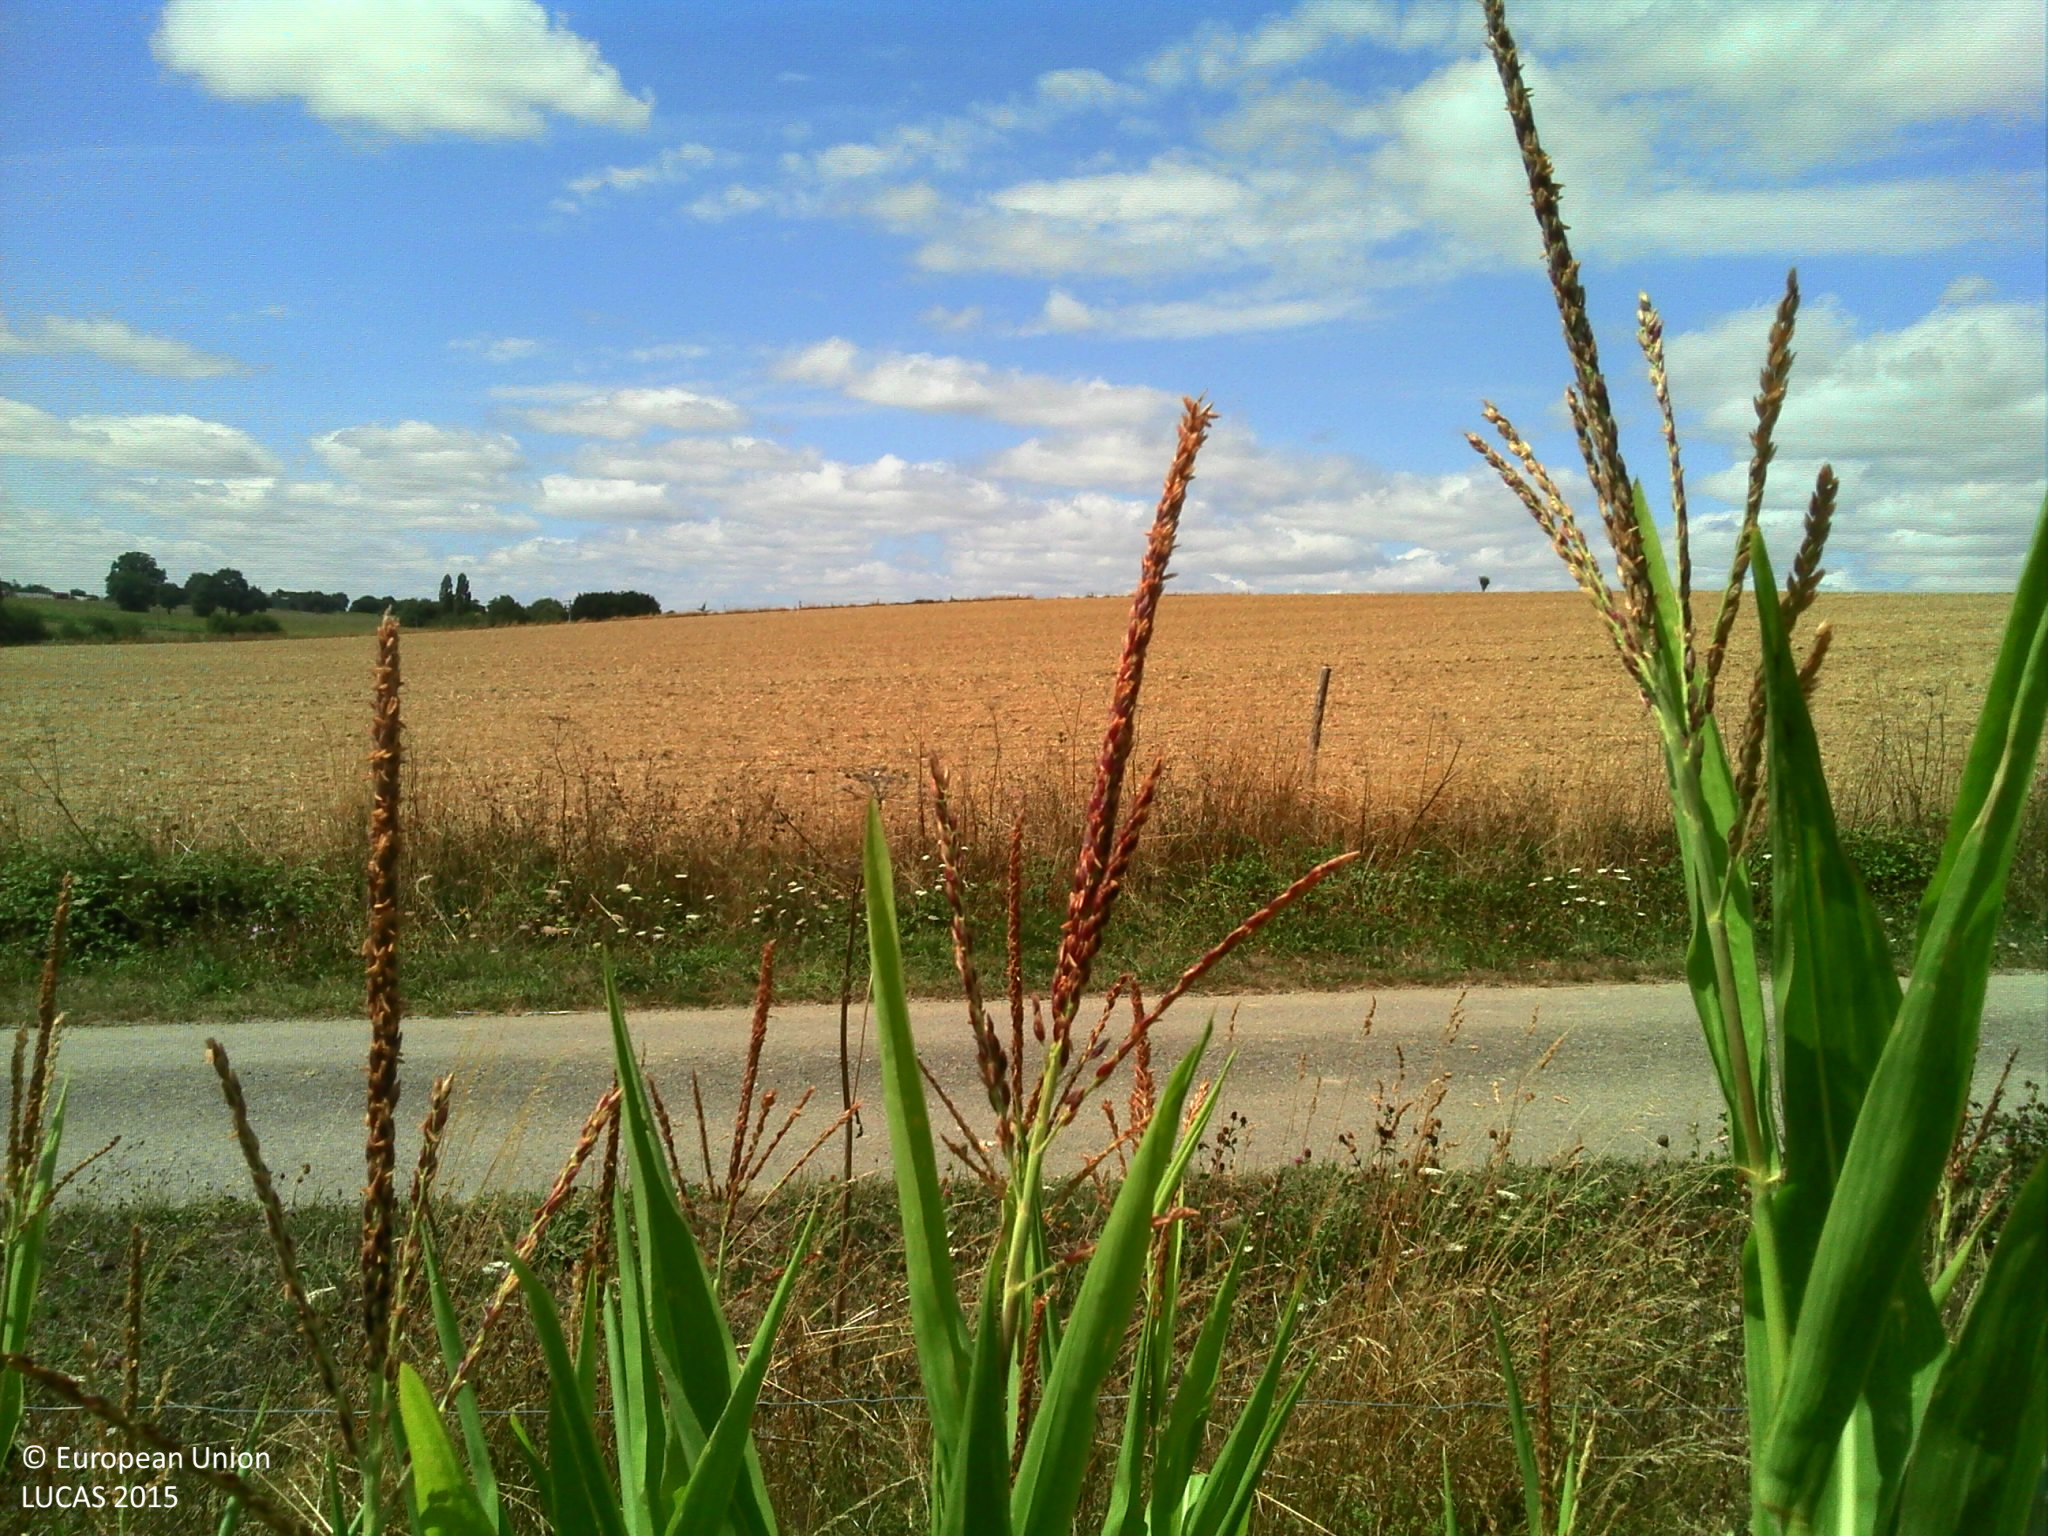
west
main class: Cropland
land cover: Maize
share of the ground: > 75 %
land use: Agriculture (excluding fallow land and kitchen gardens)
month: August
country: FR
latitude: 47.8206
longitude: -1.1390
